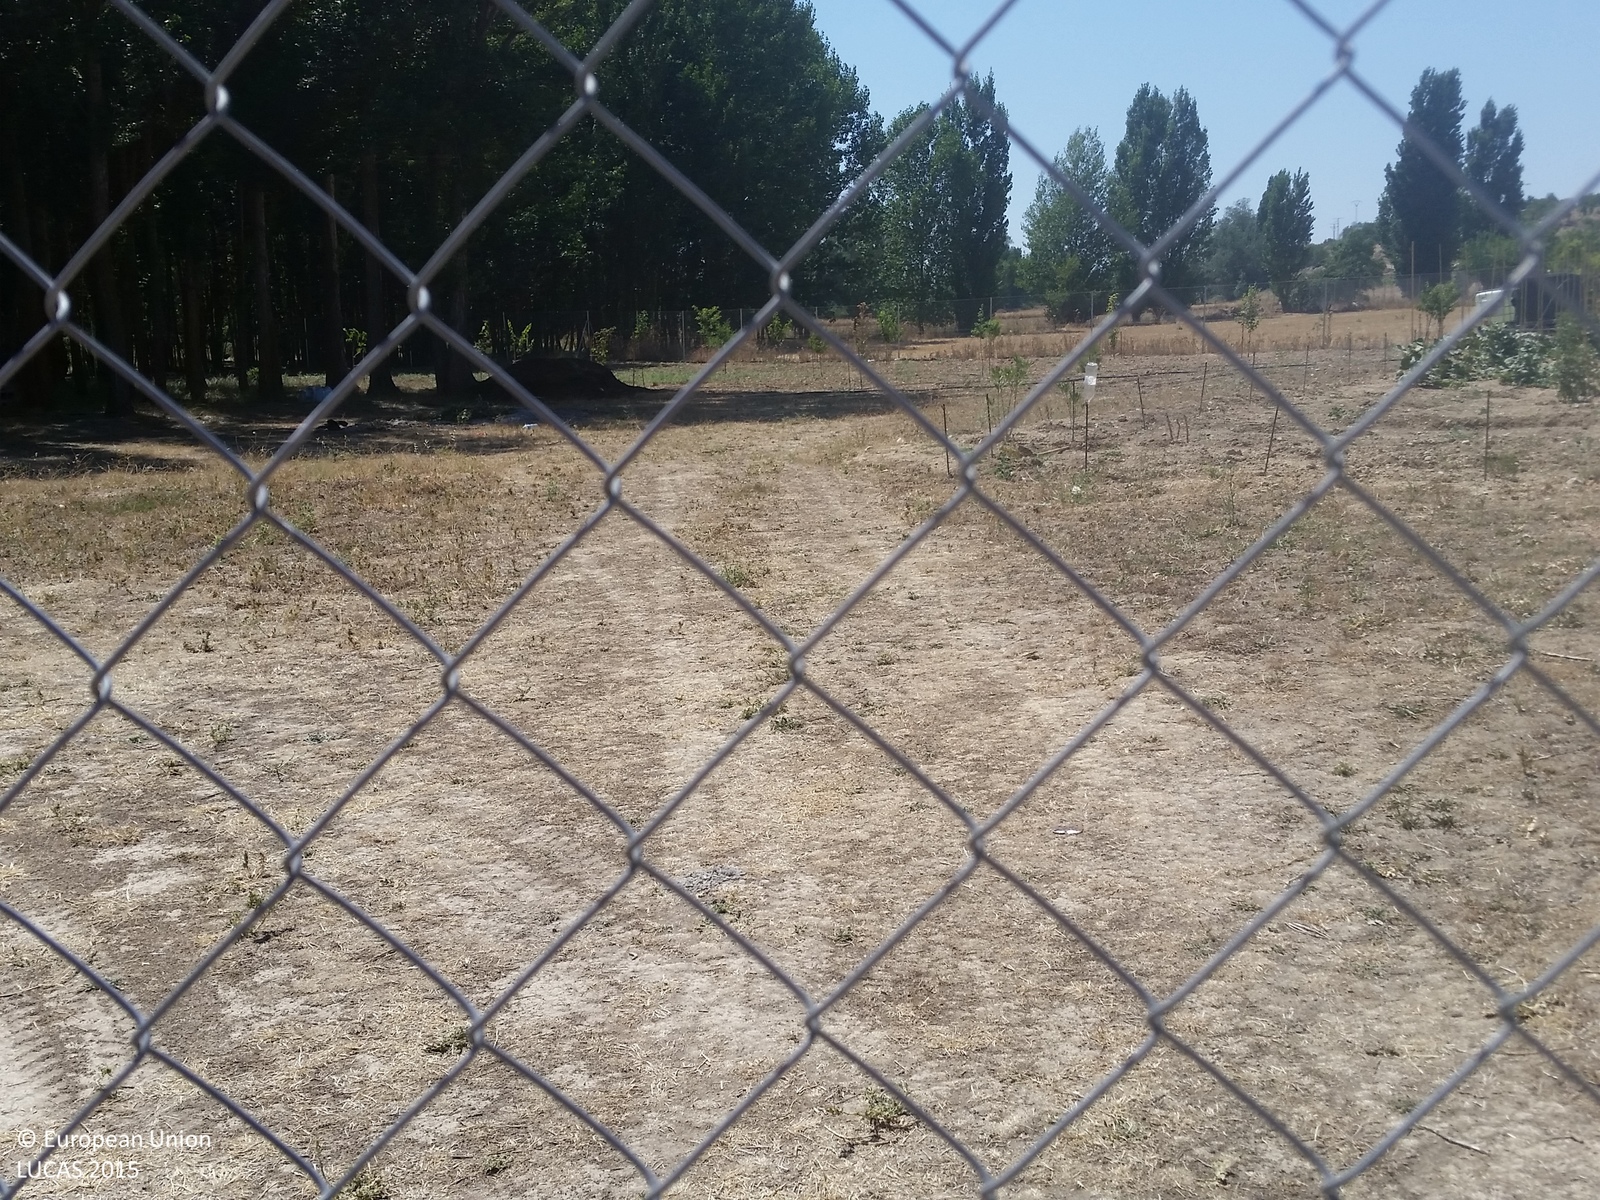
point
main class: Grassland
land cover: Grassland without tree/shrub cover
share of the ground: > 75 %
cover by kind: herbaceous plants 100 %
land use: Semi-natural and natural areas not in use
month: July
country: ES
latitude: 39.0443
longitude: -2.4960
